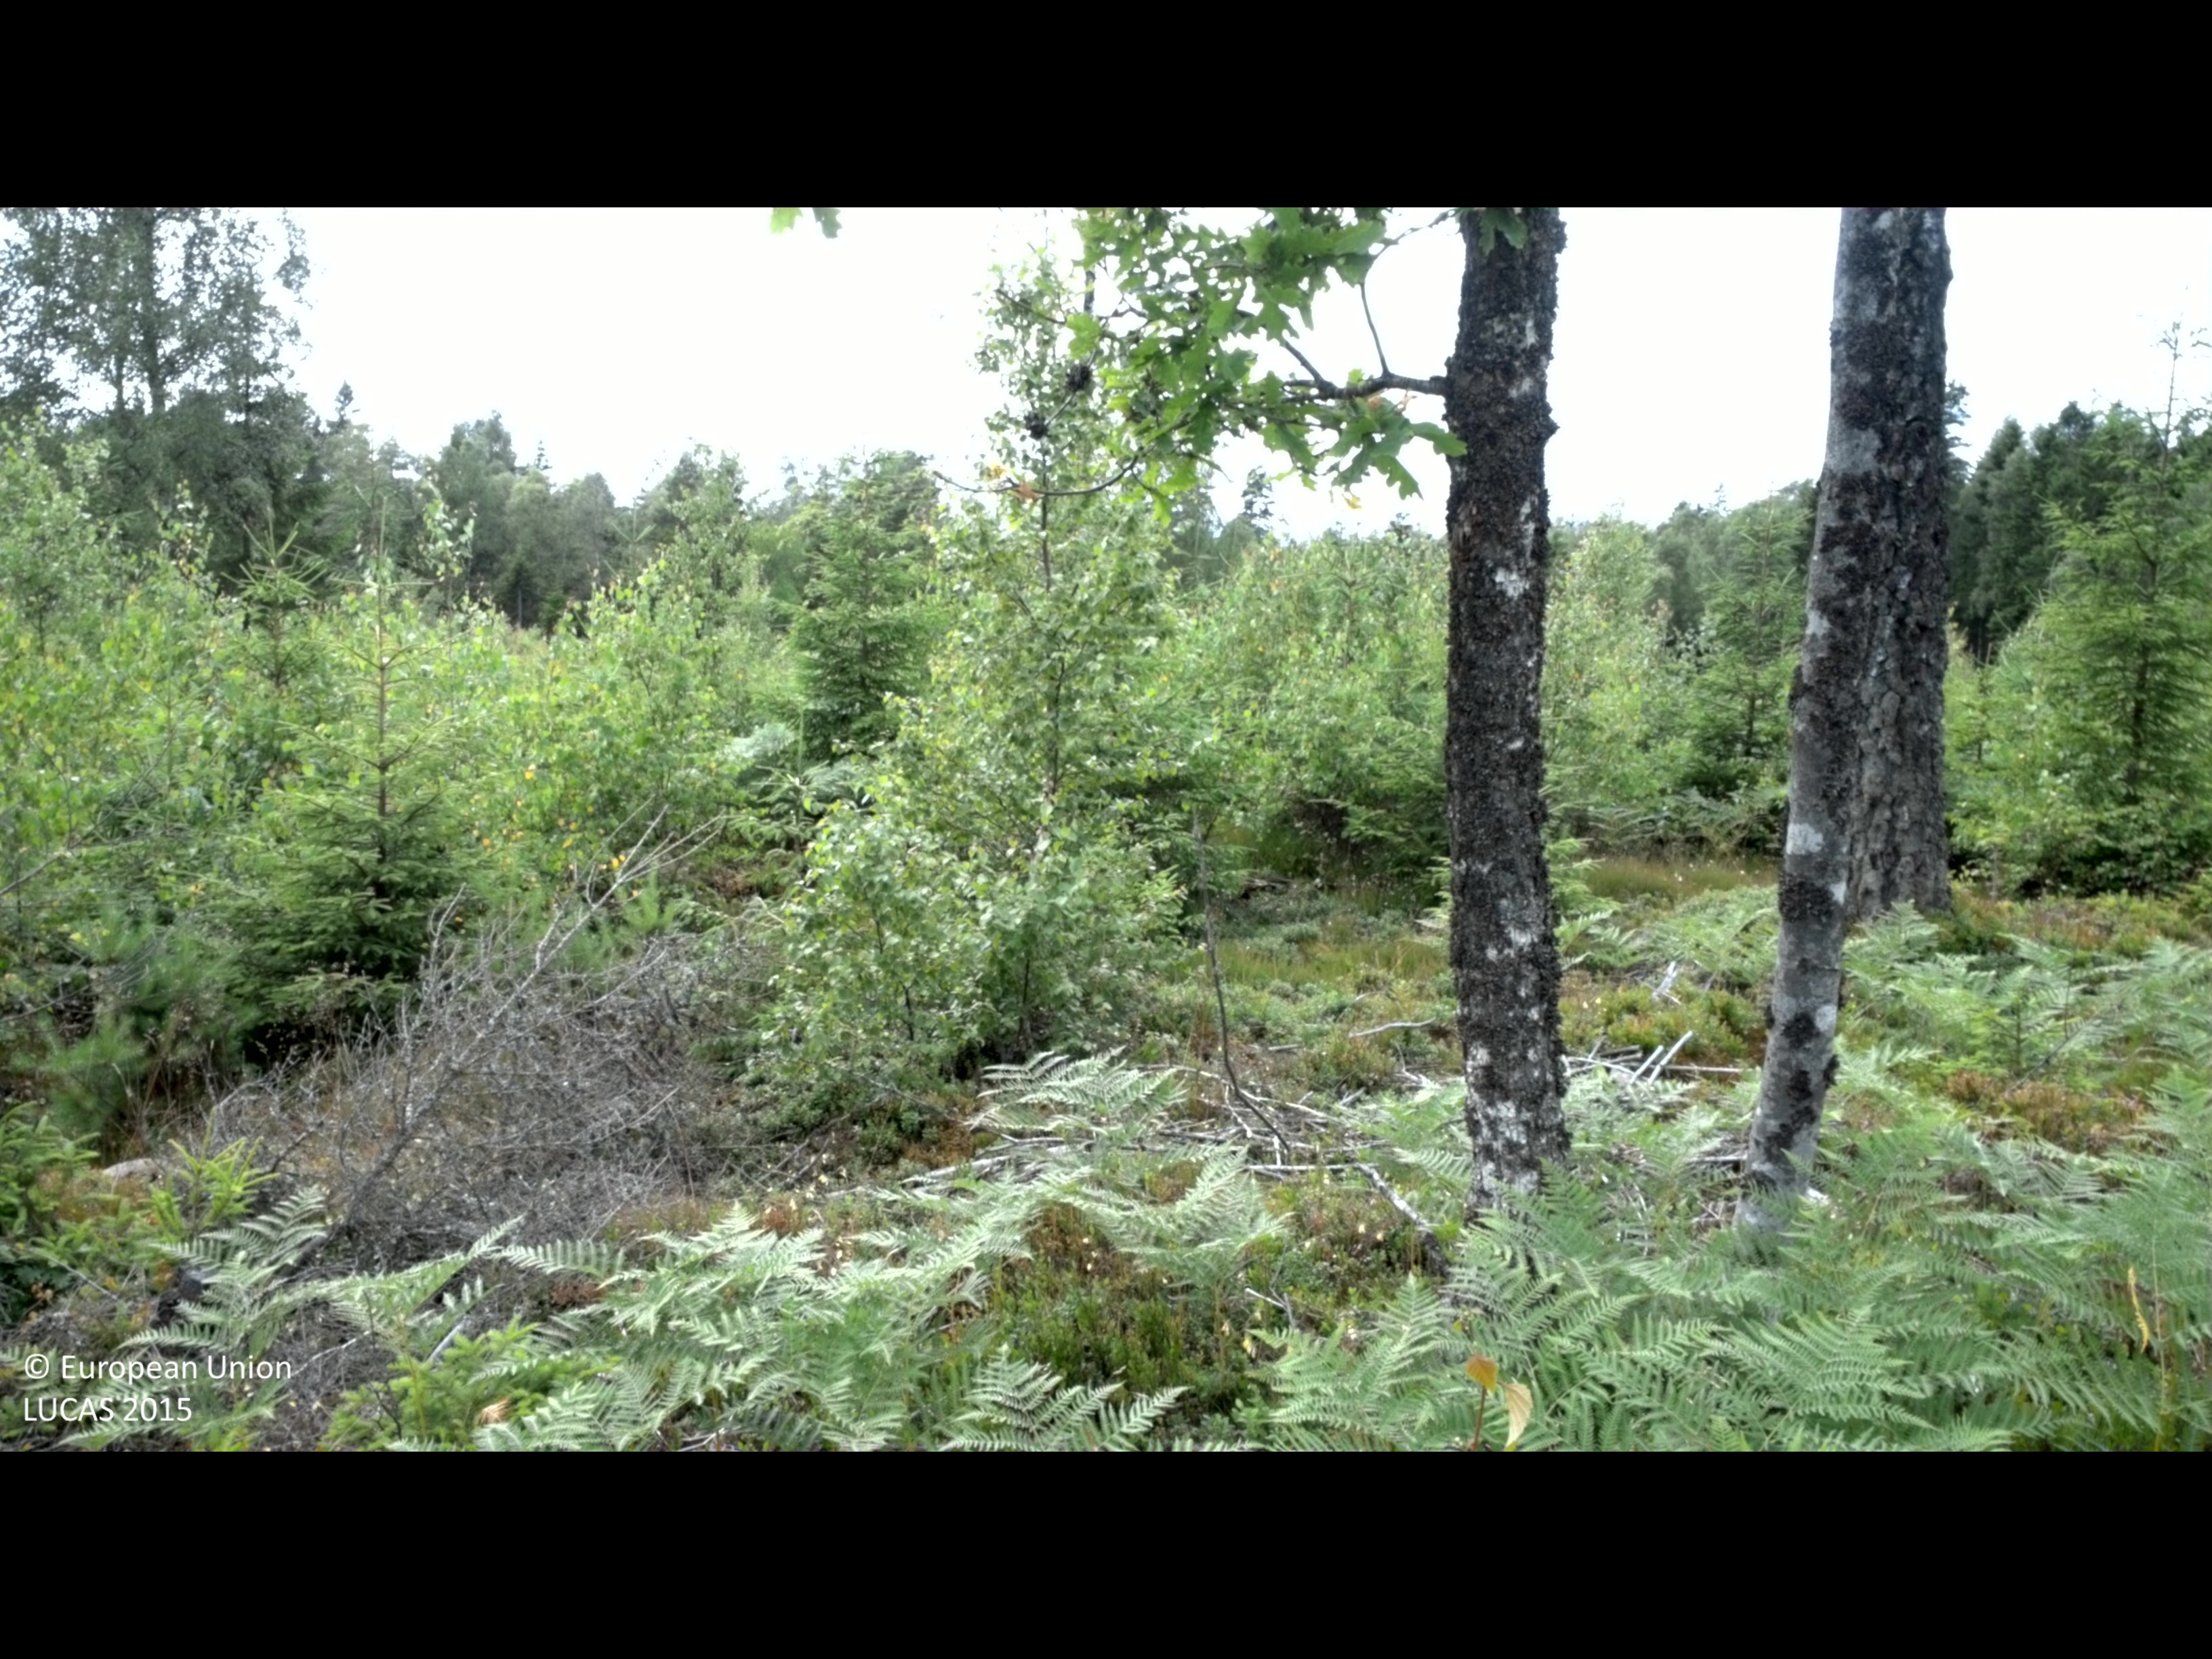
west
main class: Woodland
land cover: Other mixed woodland
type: boreal forest
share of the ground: 50 - 75 %
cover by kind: broadleaved forest trees 40 %, coniferous forest trees 25 %, shrubs 25 %, herbaceous plants 10 %
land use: Forestry
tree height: < 5 m
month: July
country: SE
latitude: 56.5201
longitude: 14.0443
